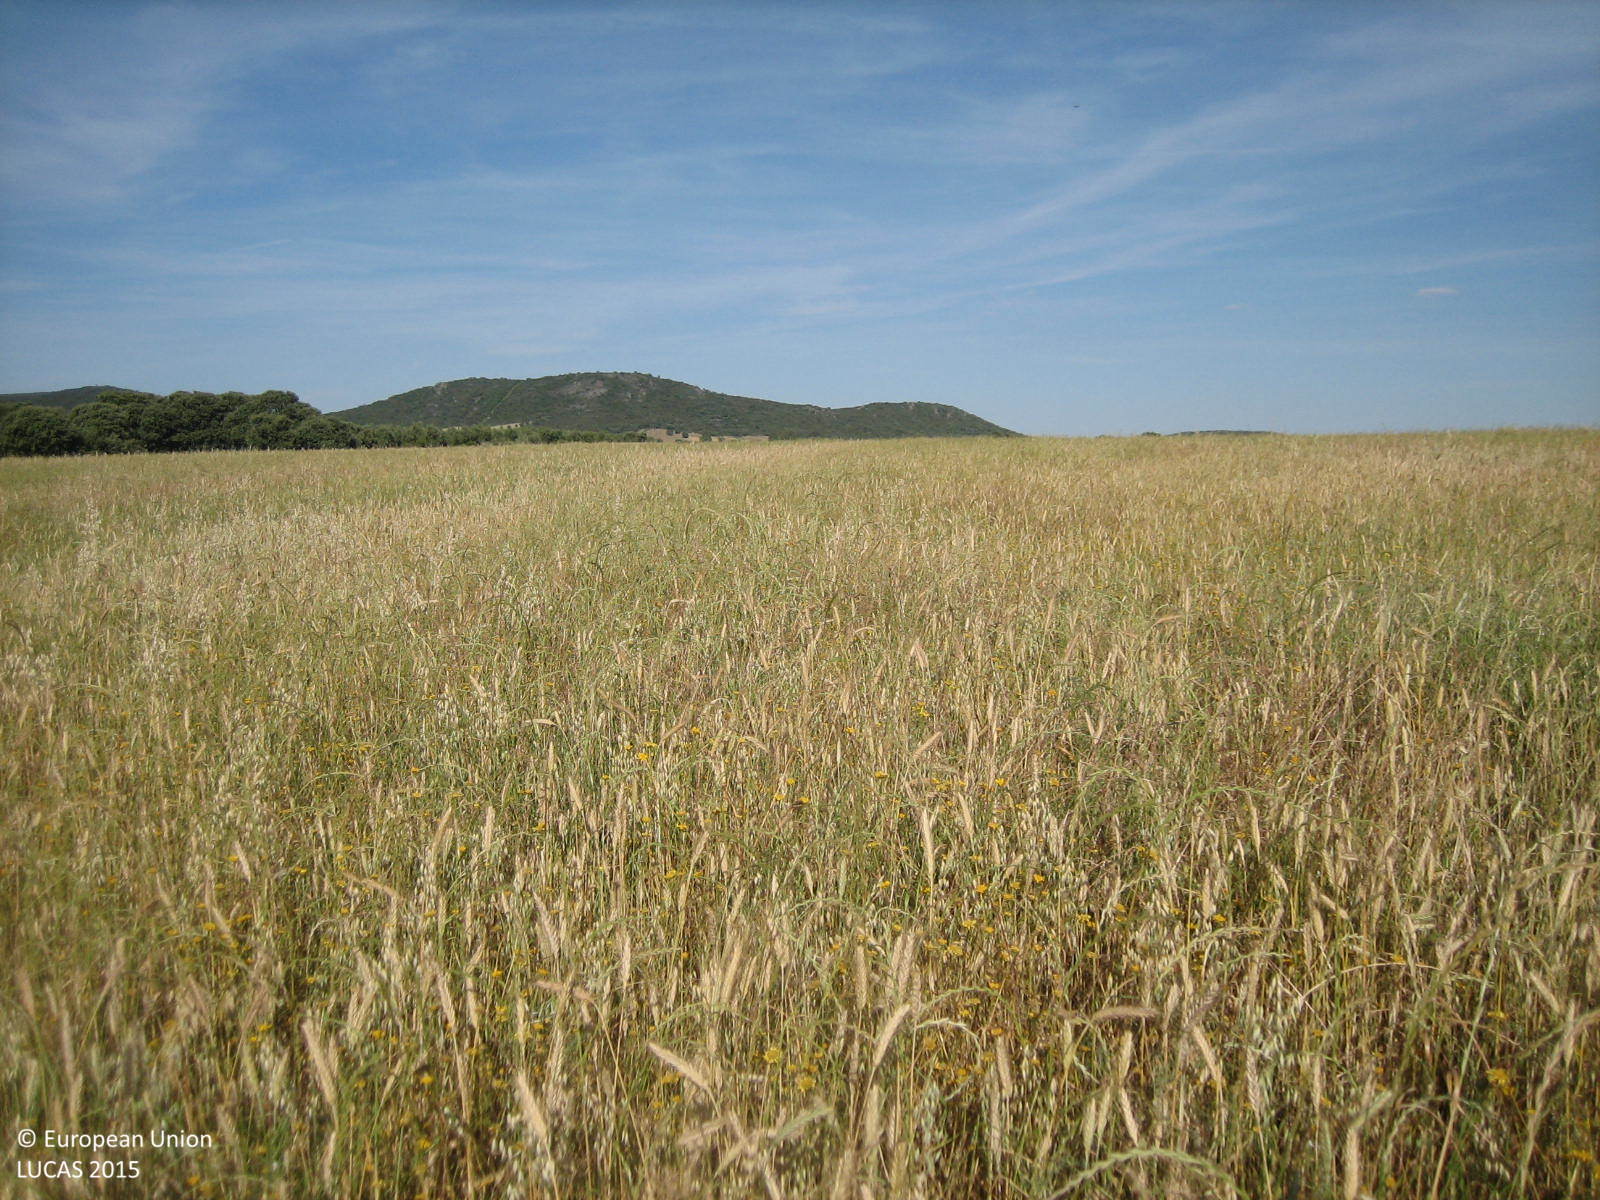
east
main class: Cropland
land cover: Mixed cereals for fodder
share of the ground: > 75 %
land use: Agriculture (excluding fallow land and kitchen gardens)
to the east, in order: Mixed cereals for fodder; Fences; Tracks
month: May
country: ES
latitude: 39.0444
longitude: -4.8109
